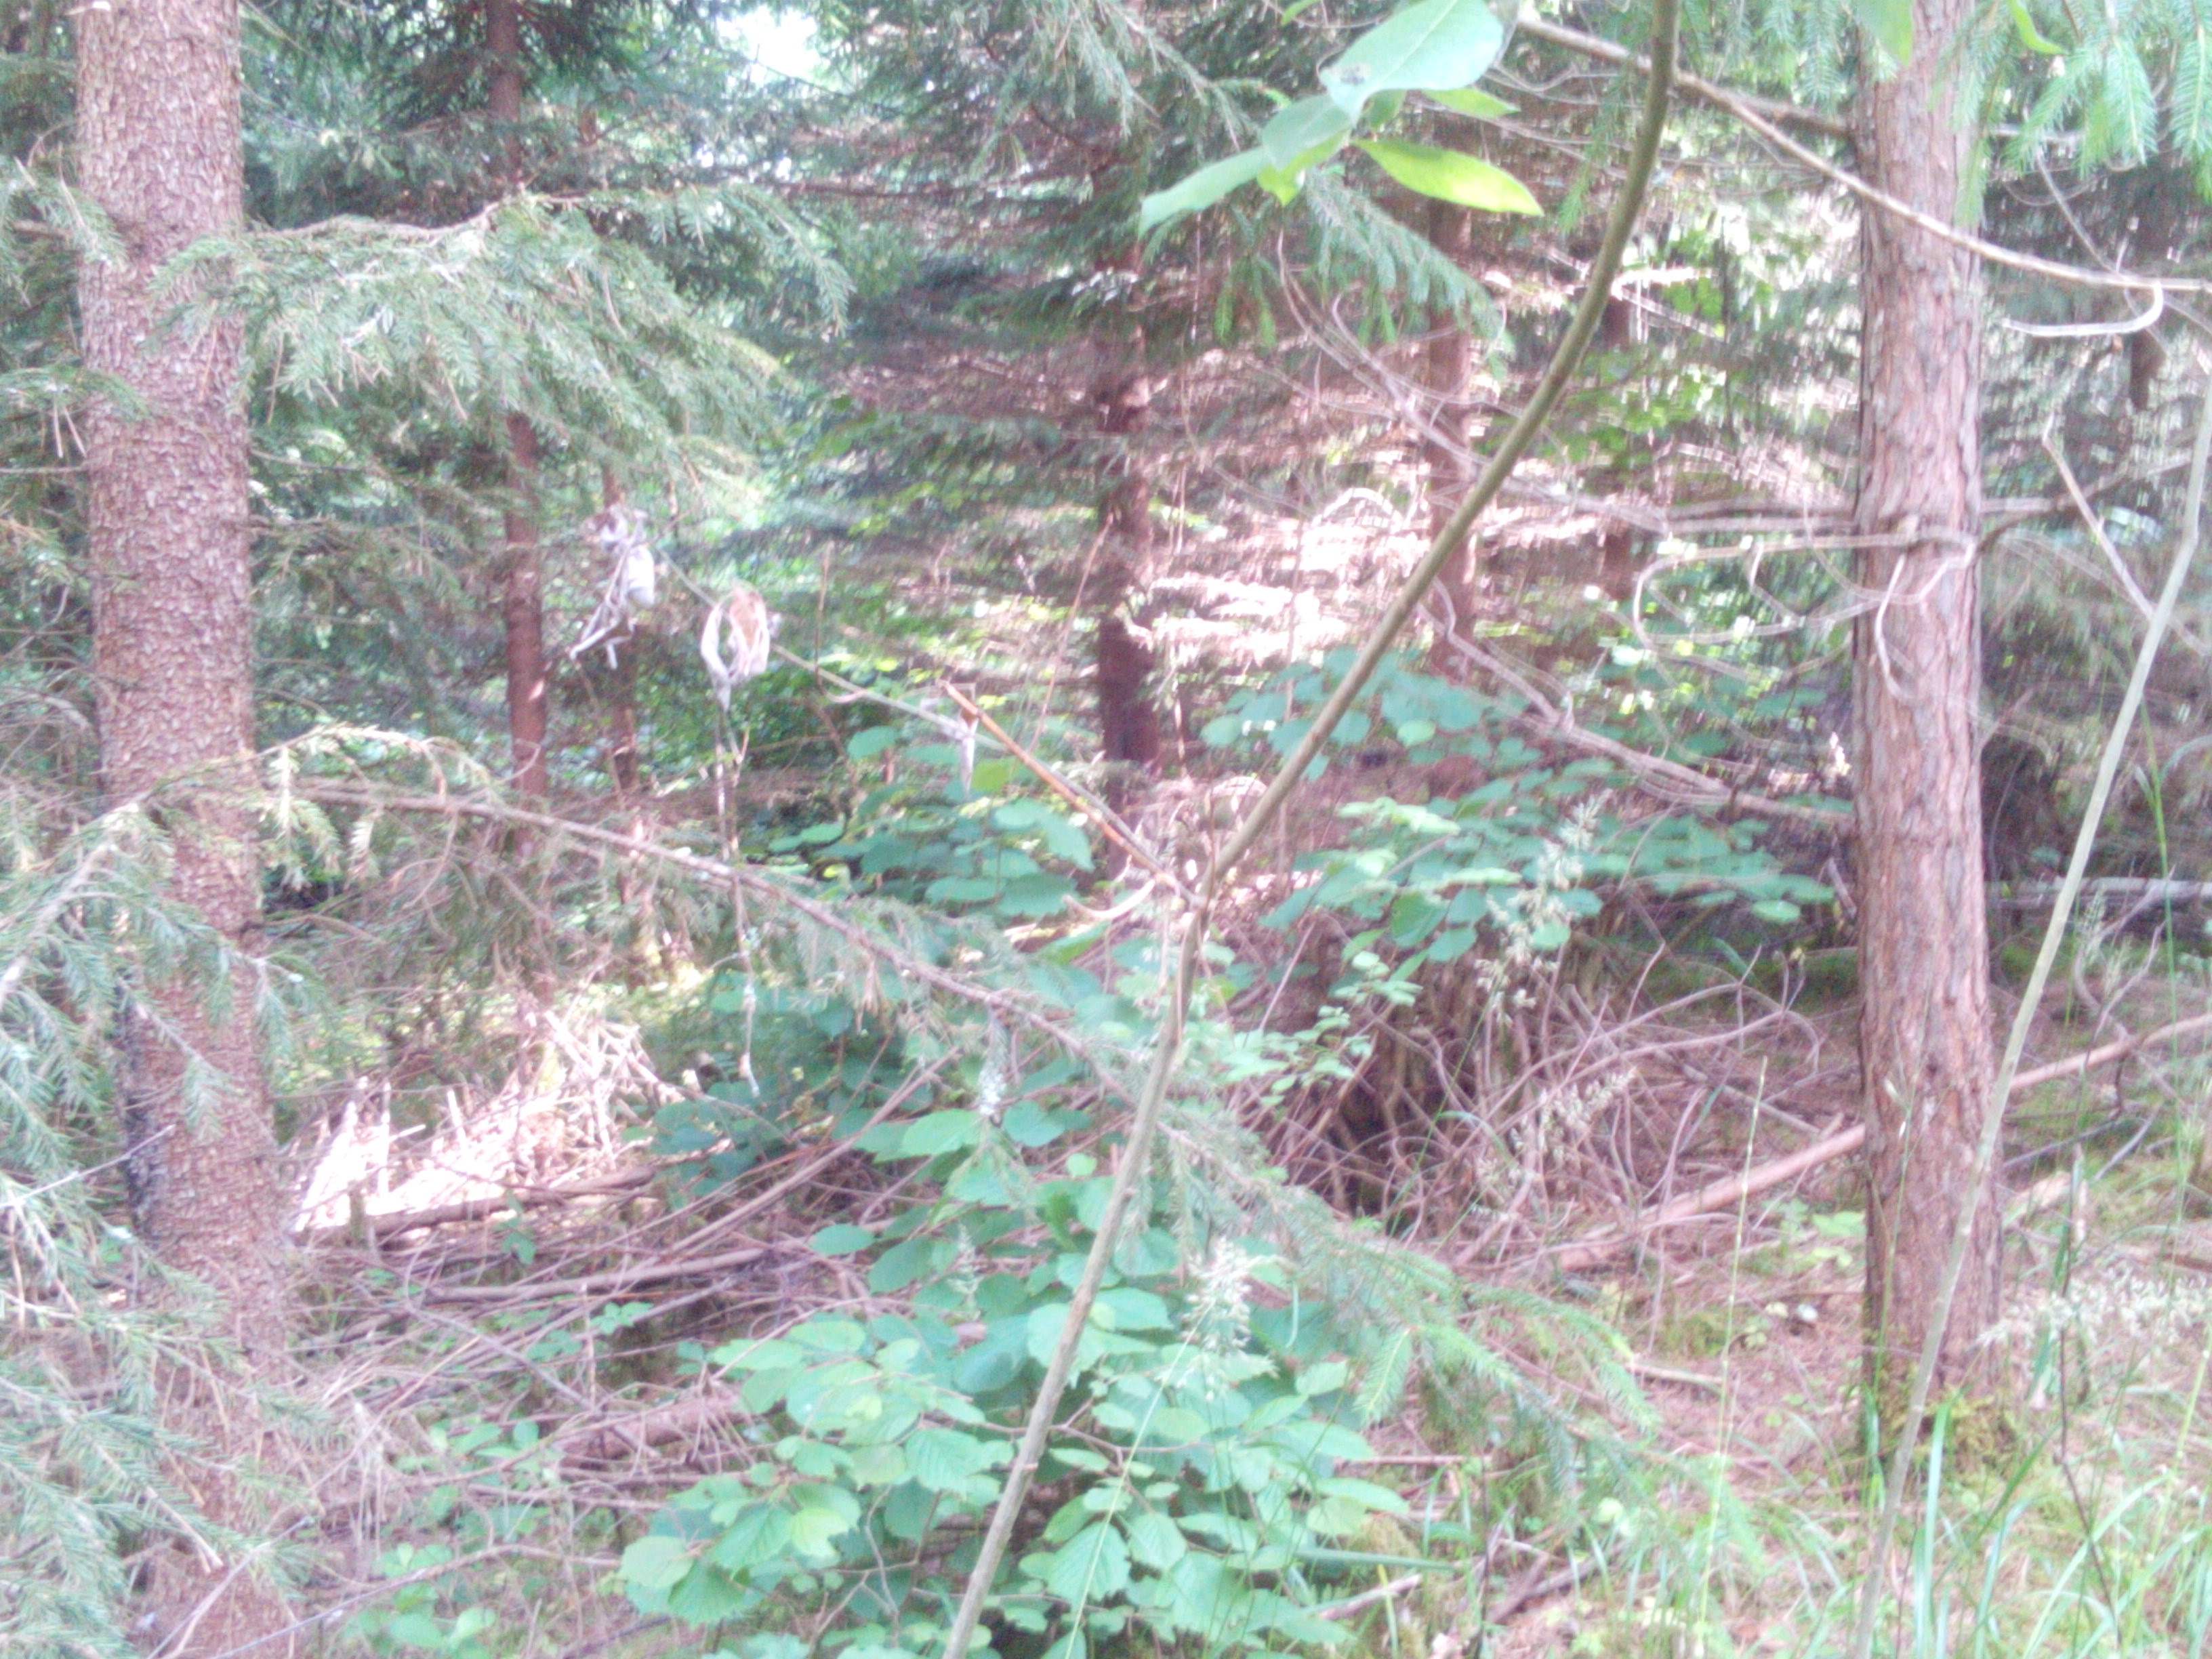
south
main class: Woodland
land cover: Spruce dominated coniferous woodland
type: hemiboreal forest and nemoral coniferous forest and mixed broadleaved-coniferous forest
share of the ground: 50 - 75 %
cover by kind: coniferous forest trees 65 %, herbaceous plants 20 %, broadleaved forest trees 15 %
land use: Forestry
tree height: > 5 m
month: July
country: LV
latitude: 56.6140
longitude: 21.2984
